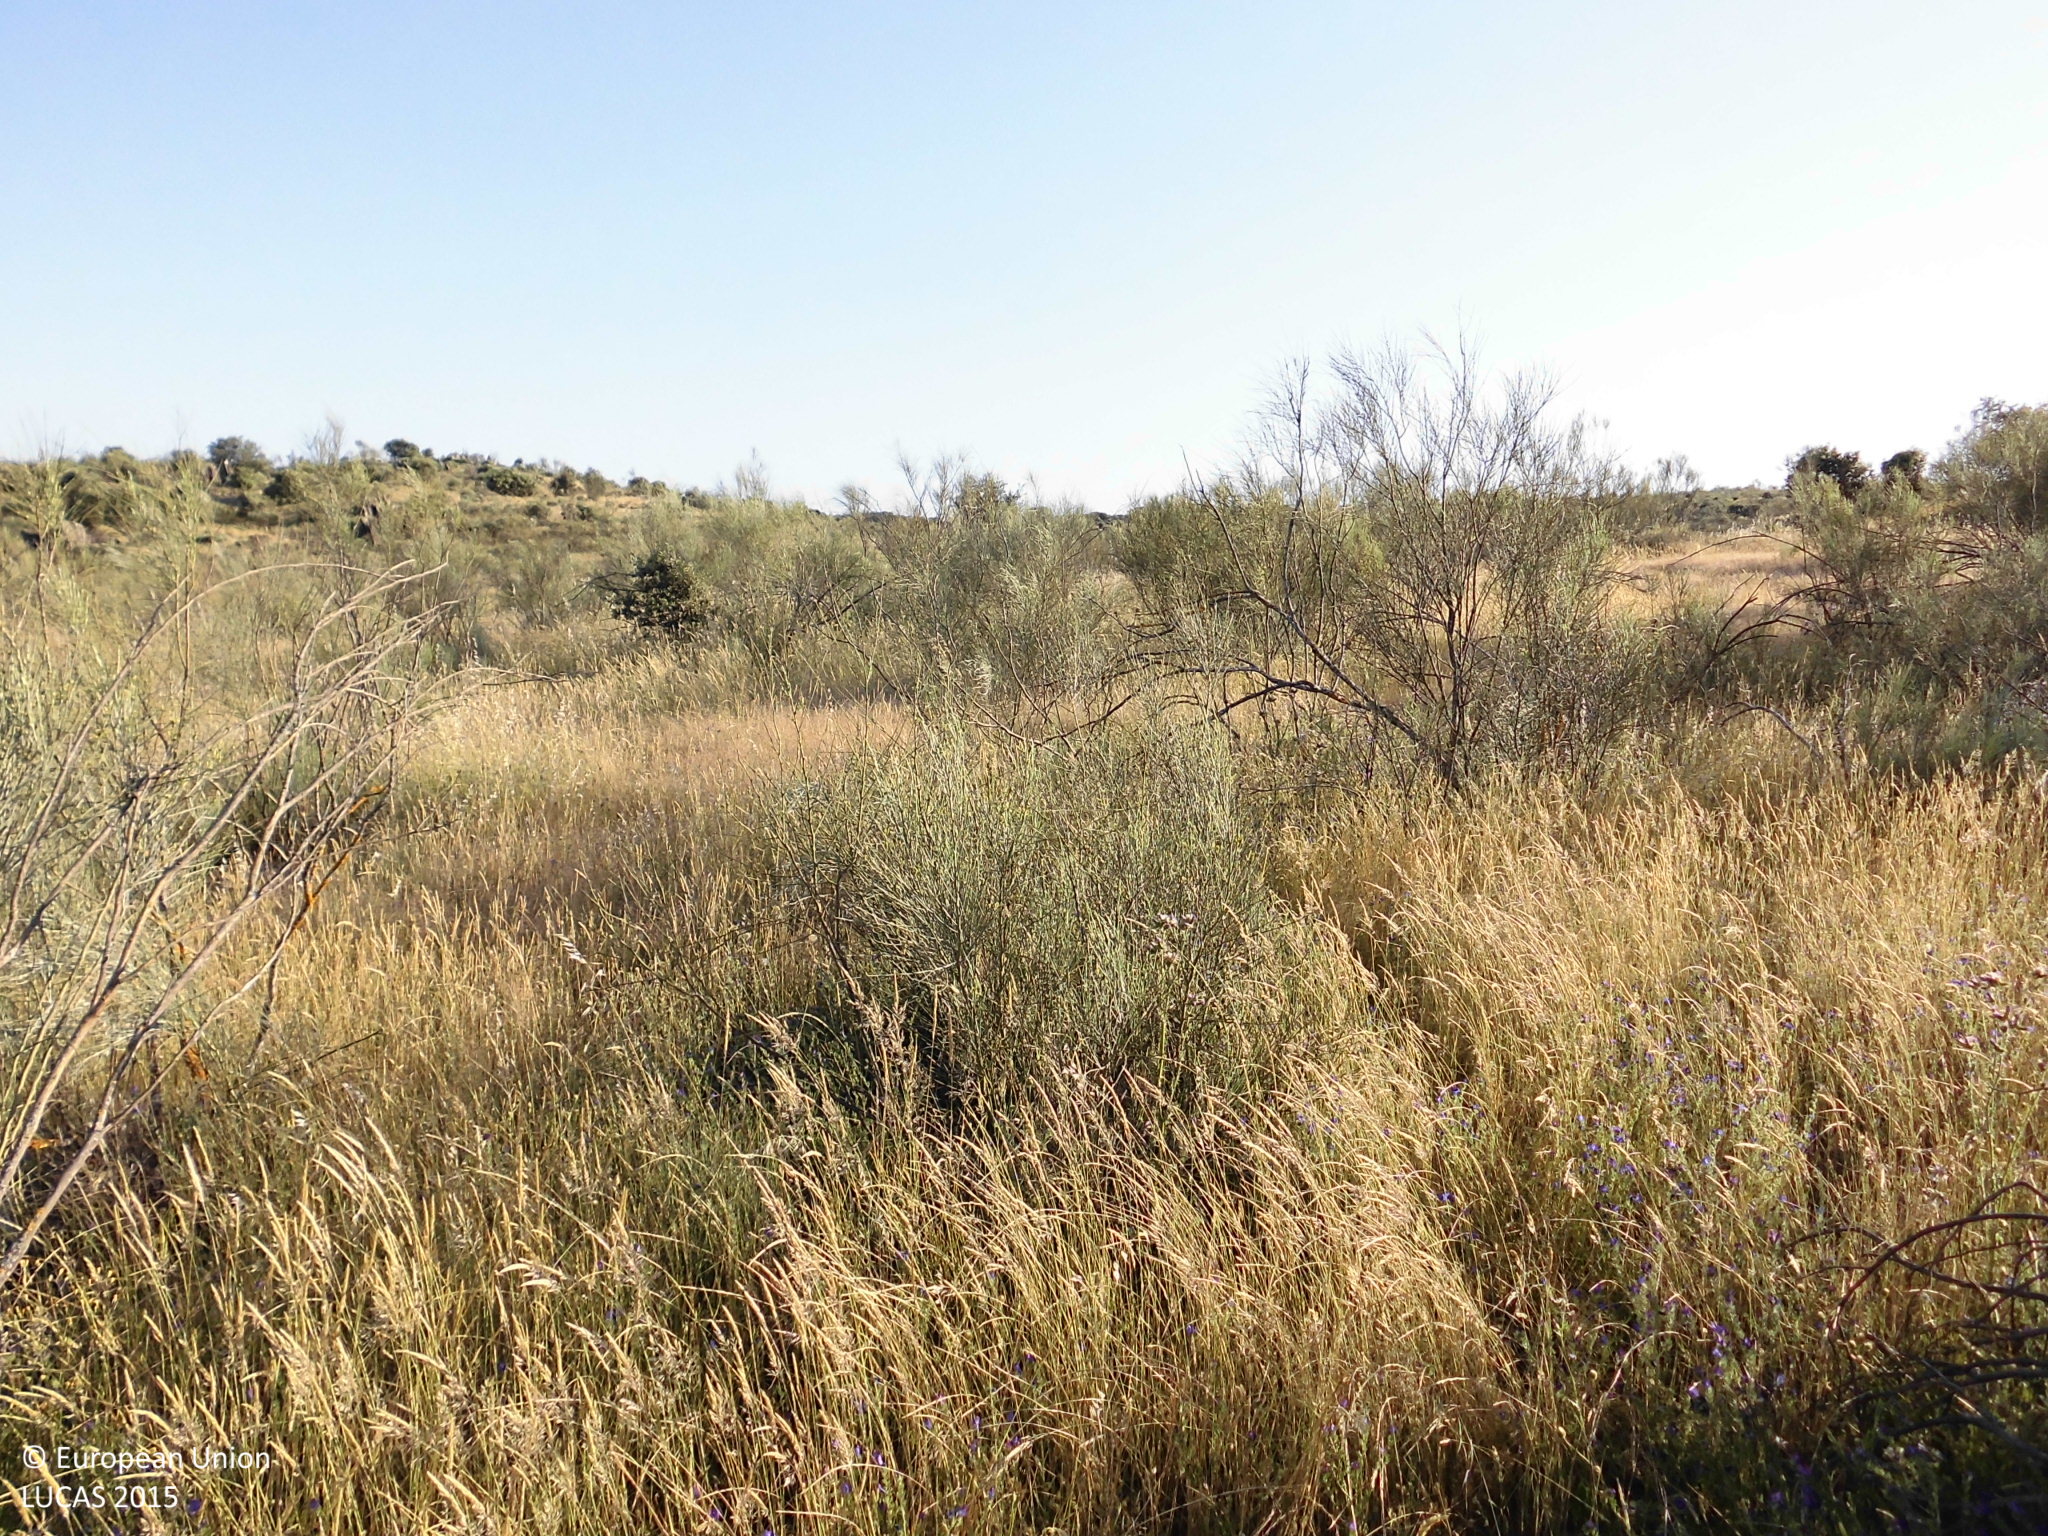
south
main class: Shrubland
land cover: Shrubland without tree cover
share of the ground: 25 - 50 %
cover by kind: herbaceous plants 75 %, shrubs 25 %
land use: Agriculture (excluding fallow land and kitchen gardens)
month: May
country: ES
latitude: 39.4886
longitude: -6.0490
